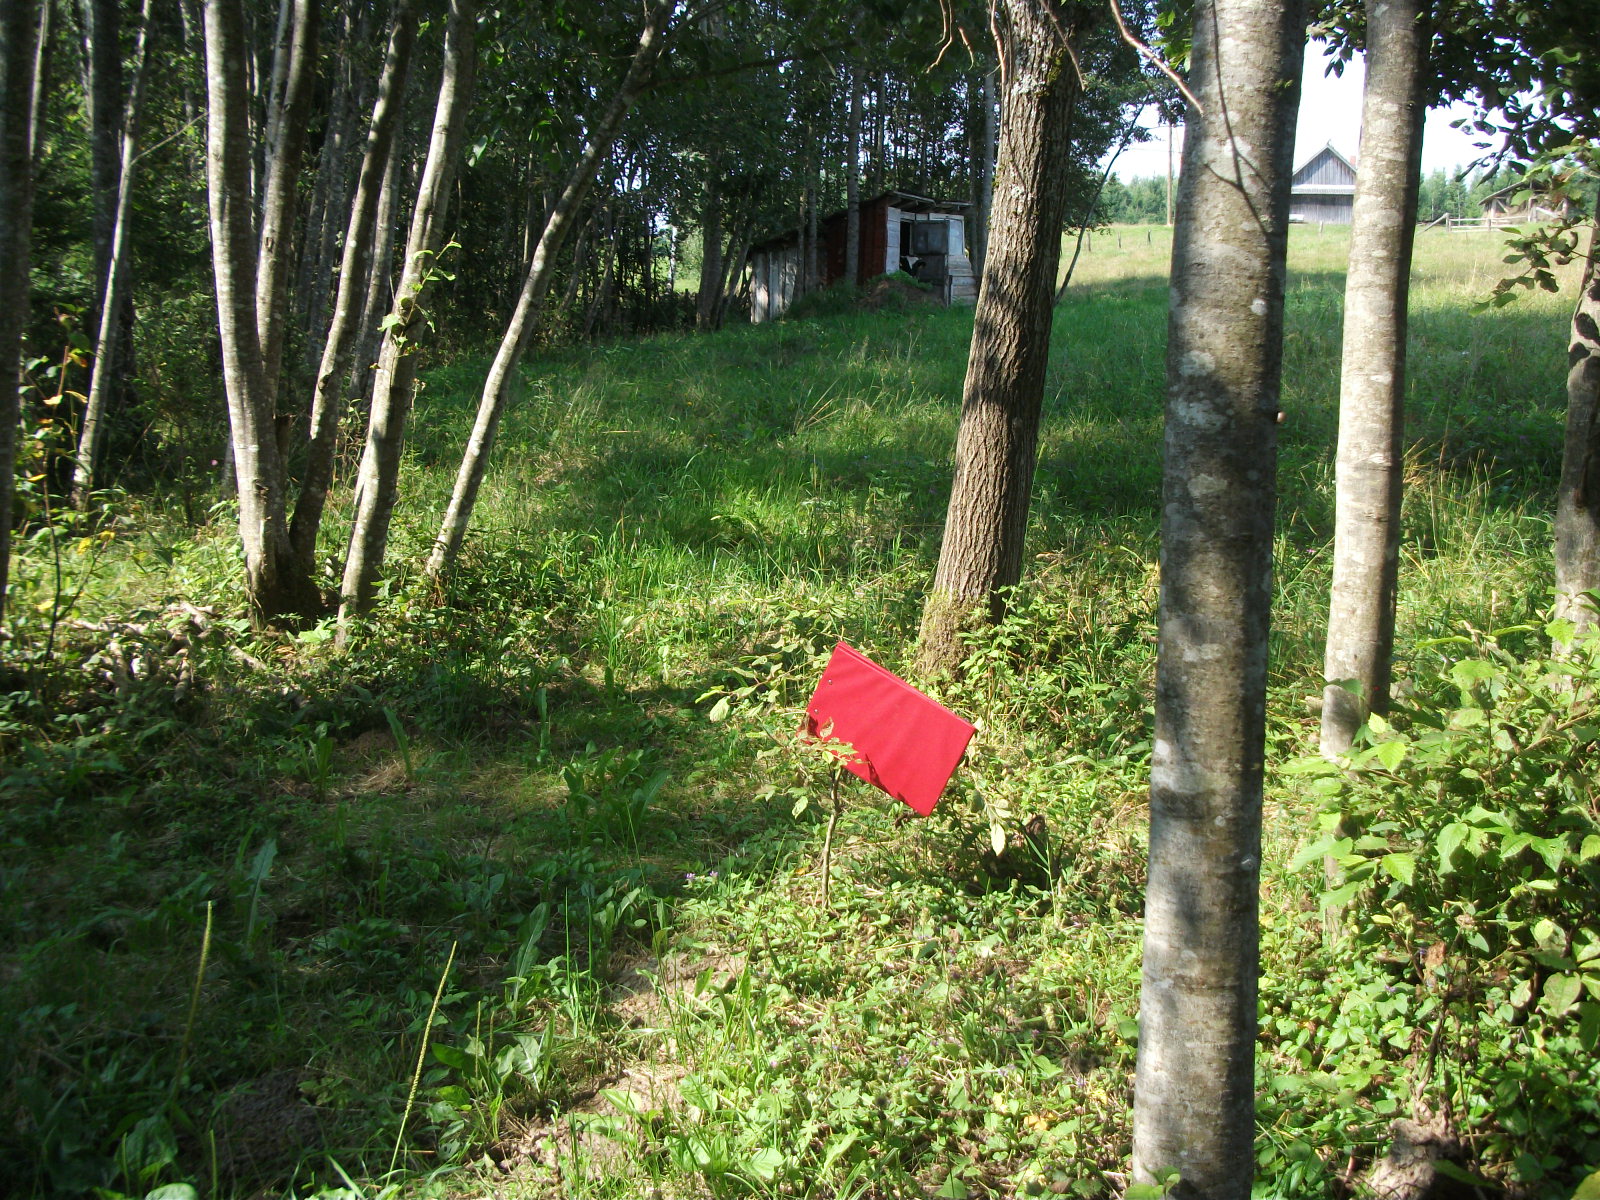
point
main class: Woodland
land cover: Broadleaved woodland
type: non-riverine alder, birch or aspen forest
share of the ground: 50 - 75 %
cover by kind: broadleaved forest trees 80 %, herbaceous plants 20 %
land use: Forestry
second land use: Agriculture (excluding fallow land and kitchen gardens)
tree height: > 5 m
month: August
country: LV
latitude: 56.8043
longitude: 25.5973
